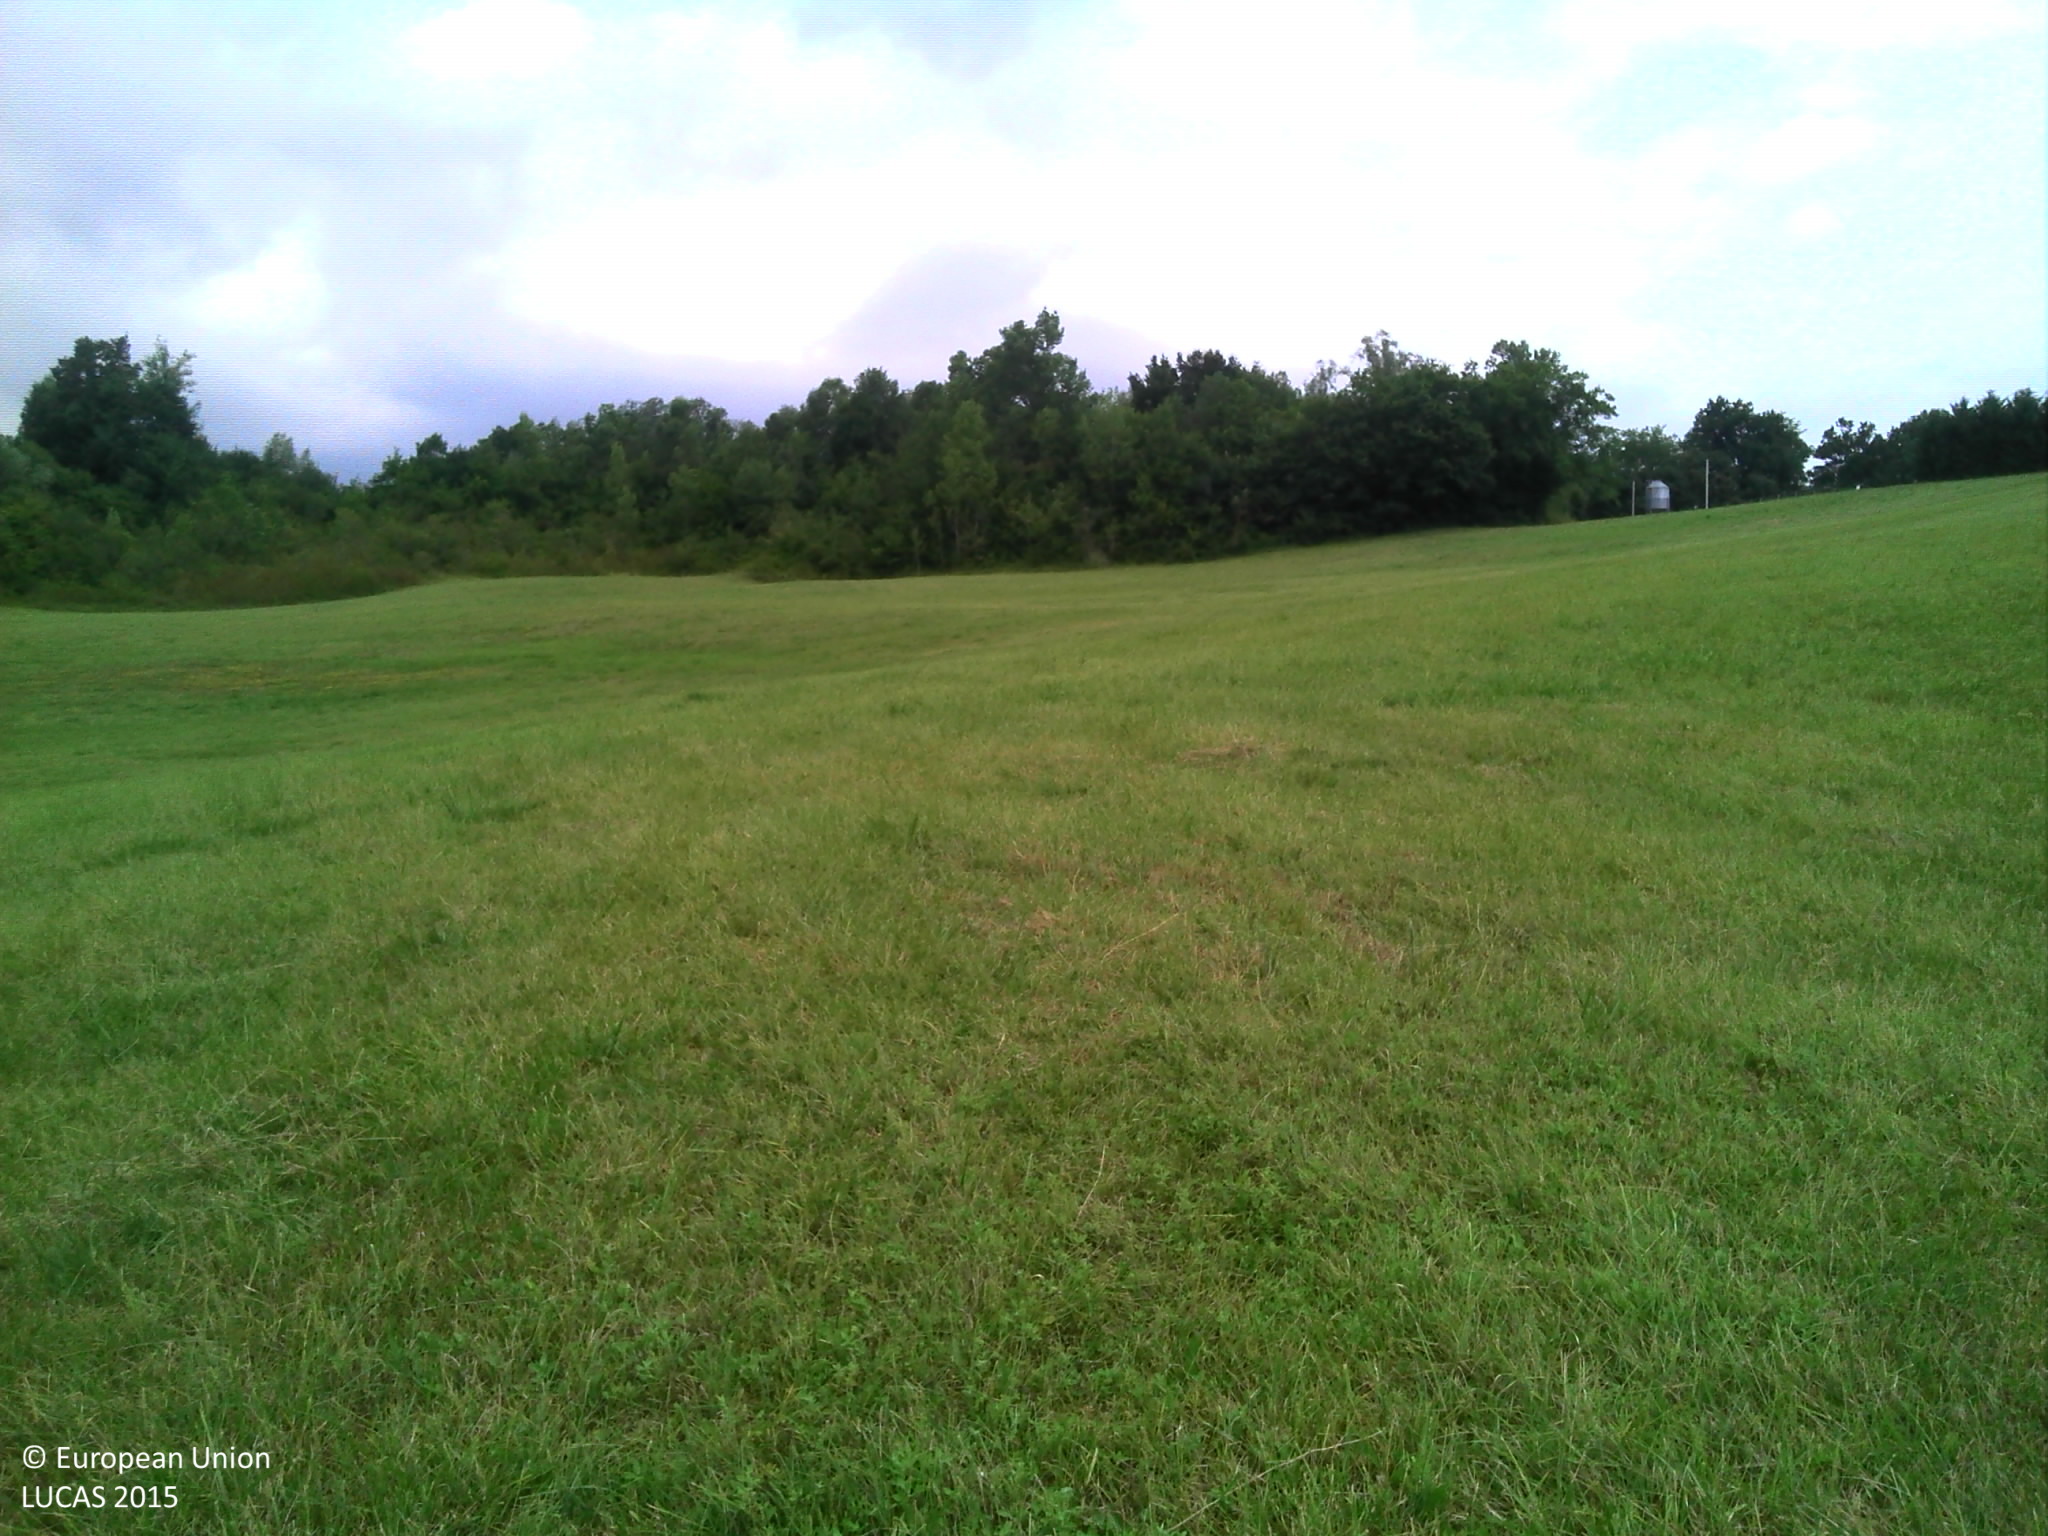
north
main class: Grassland
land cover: Grassland without tree/shrub cover
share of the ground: > 75 %
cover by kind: herbaceous plants 100 %
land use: Agriculture (excluding fallow land and kitchen gardens)
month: July
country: FR
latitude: 43.6591
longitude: -0.7885
